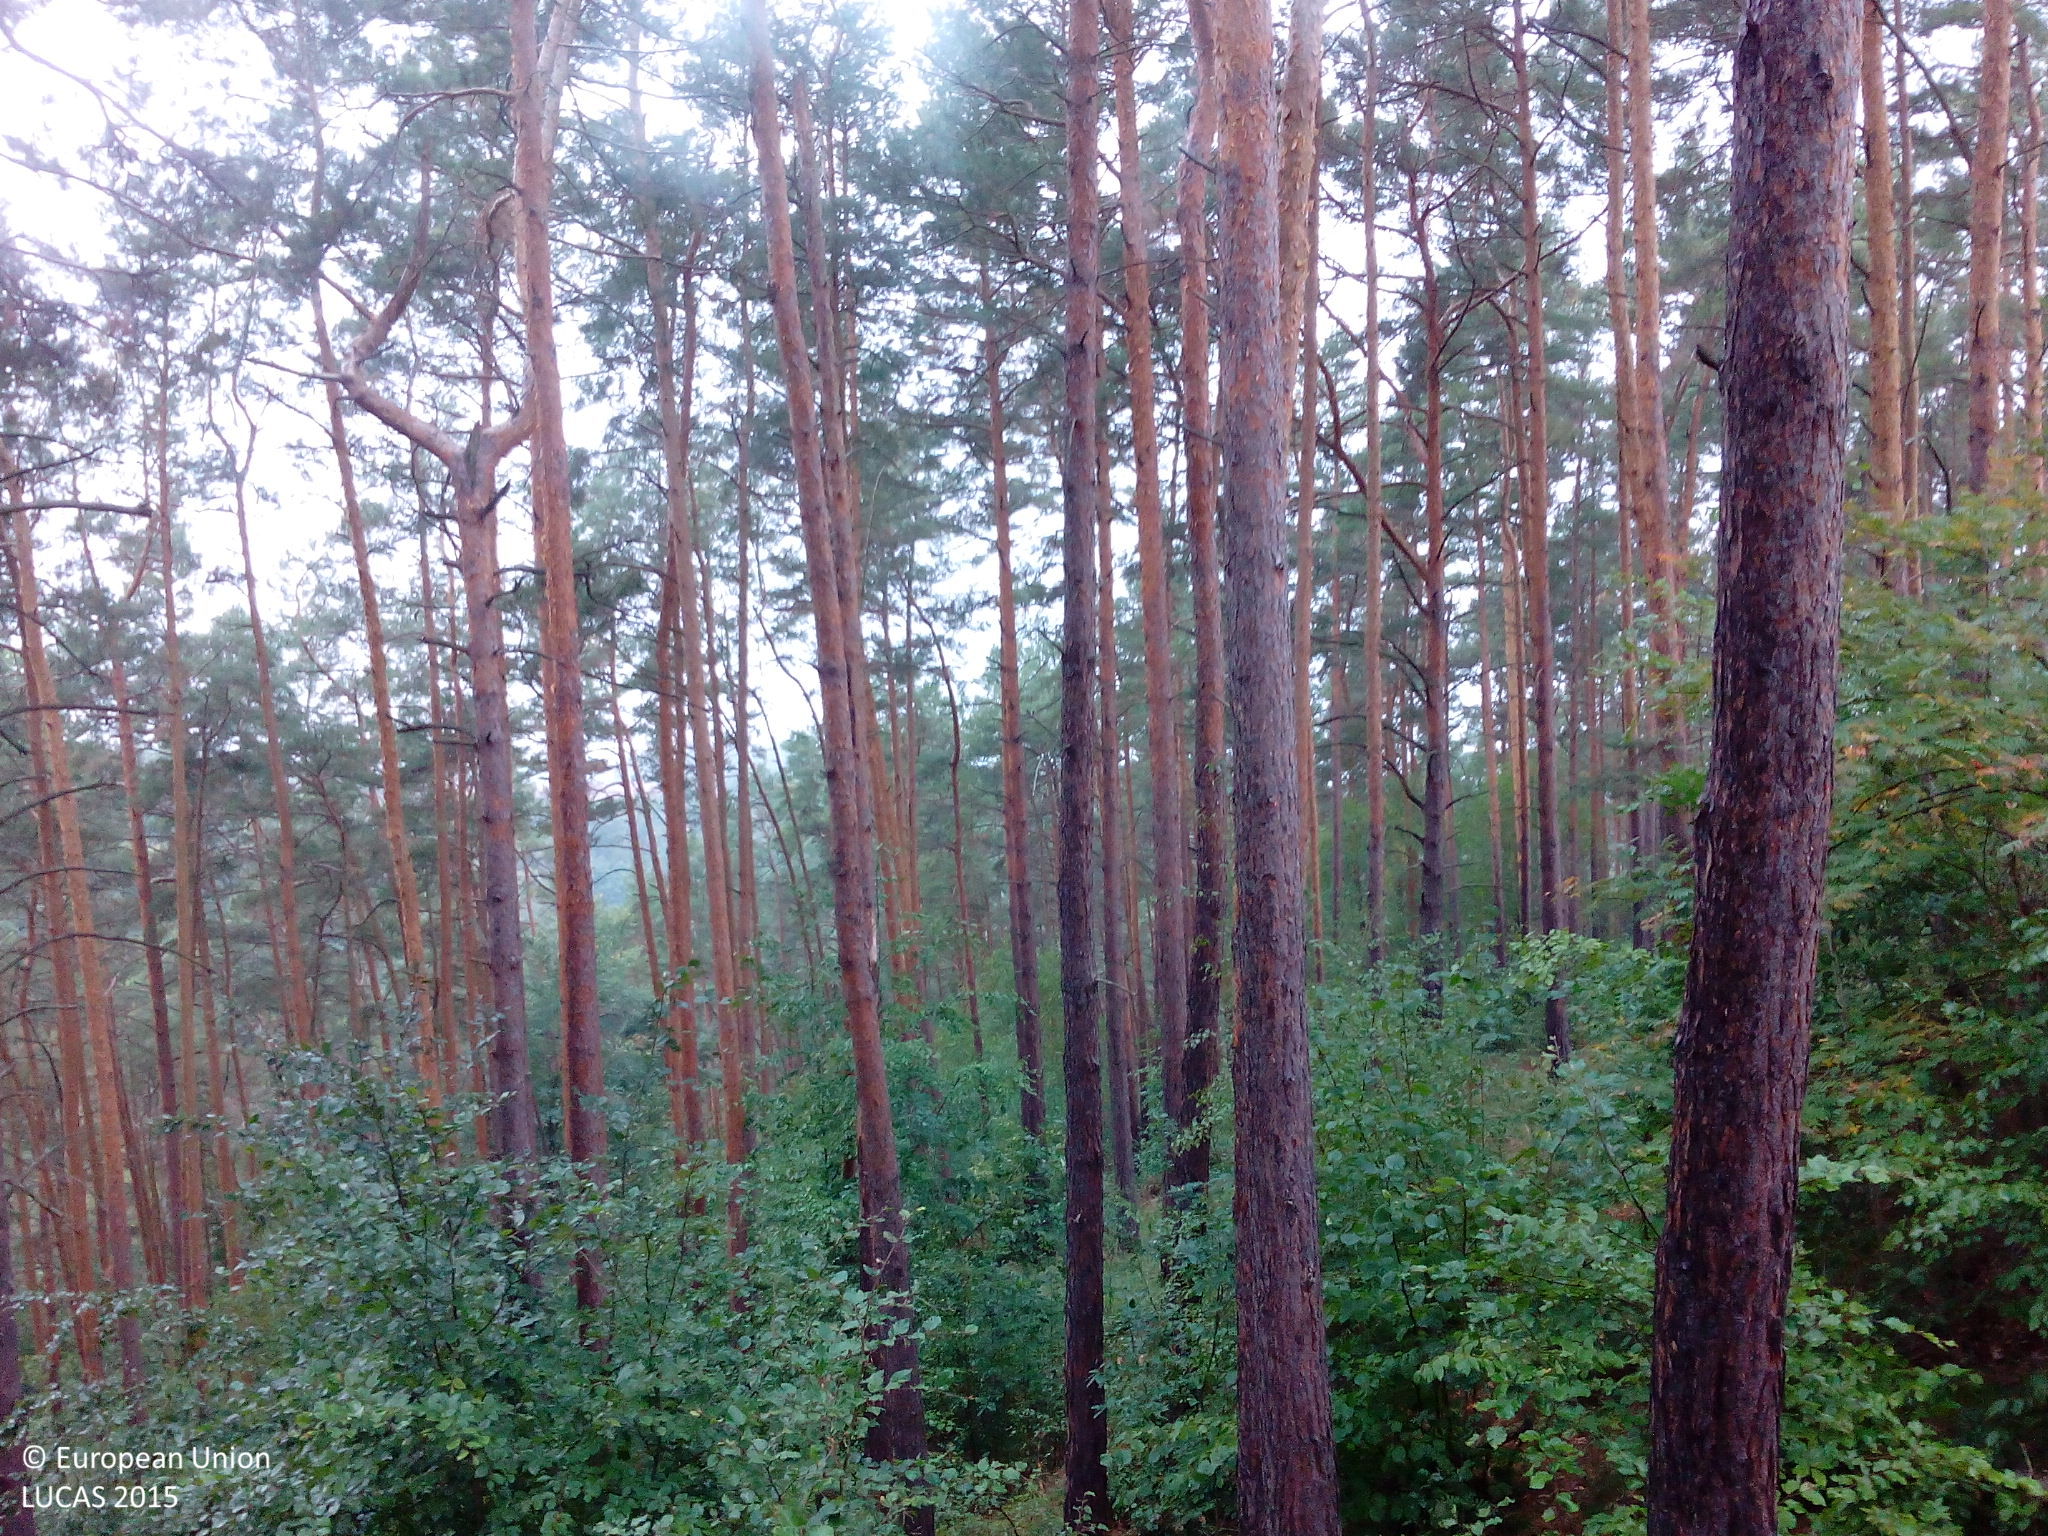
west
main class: Woodland
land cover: Pine dominated mixed woodland
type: hemiboreal forest and nemoral coniferous forest and mixed broadleaved-coniferous forest
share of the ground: > 75 %
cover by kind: coniferous forest trees 75 %, broadleaved forest trees 25 %
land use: Forestry
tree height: > 5 m
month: September
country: DE
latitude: 51.4203
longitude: 11.0207
